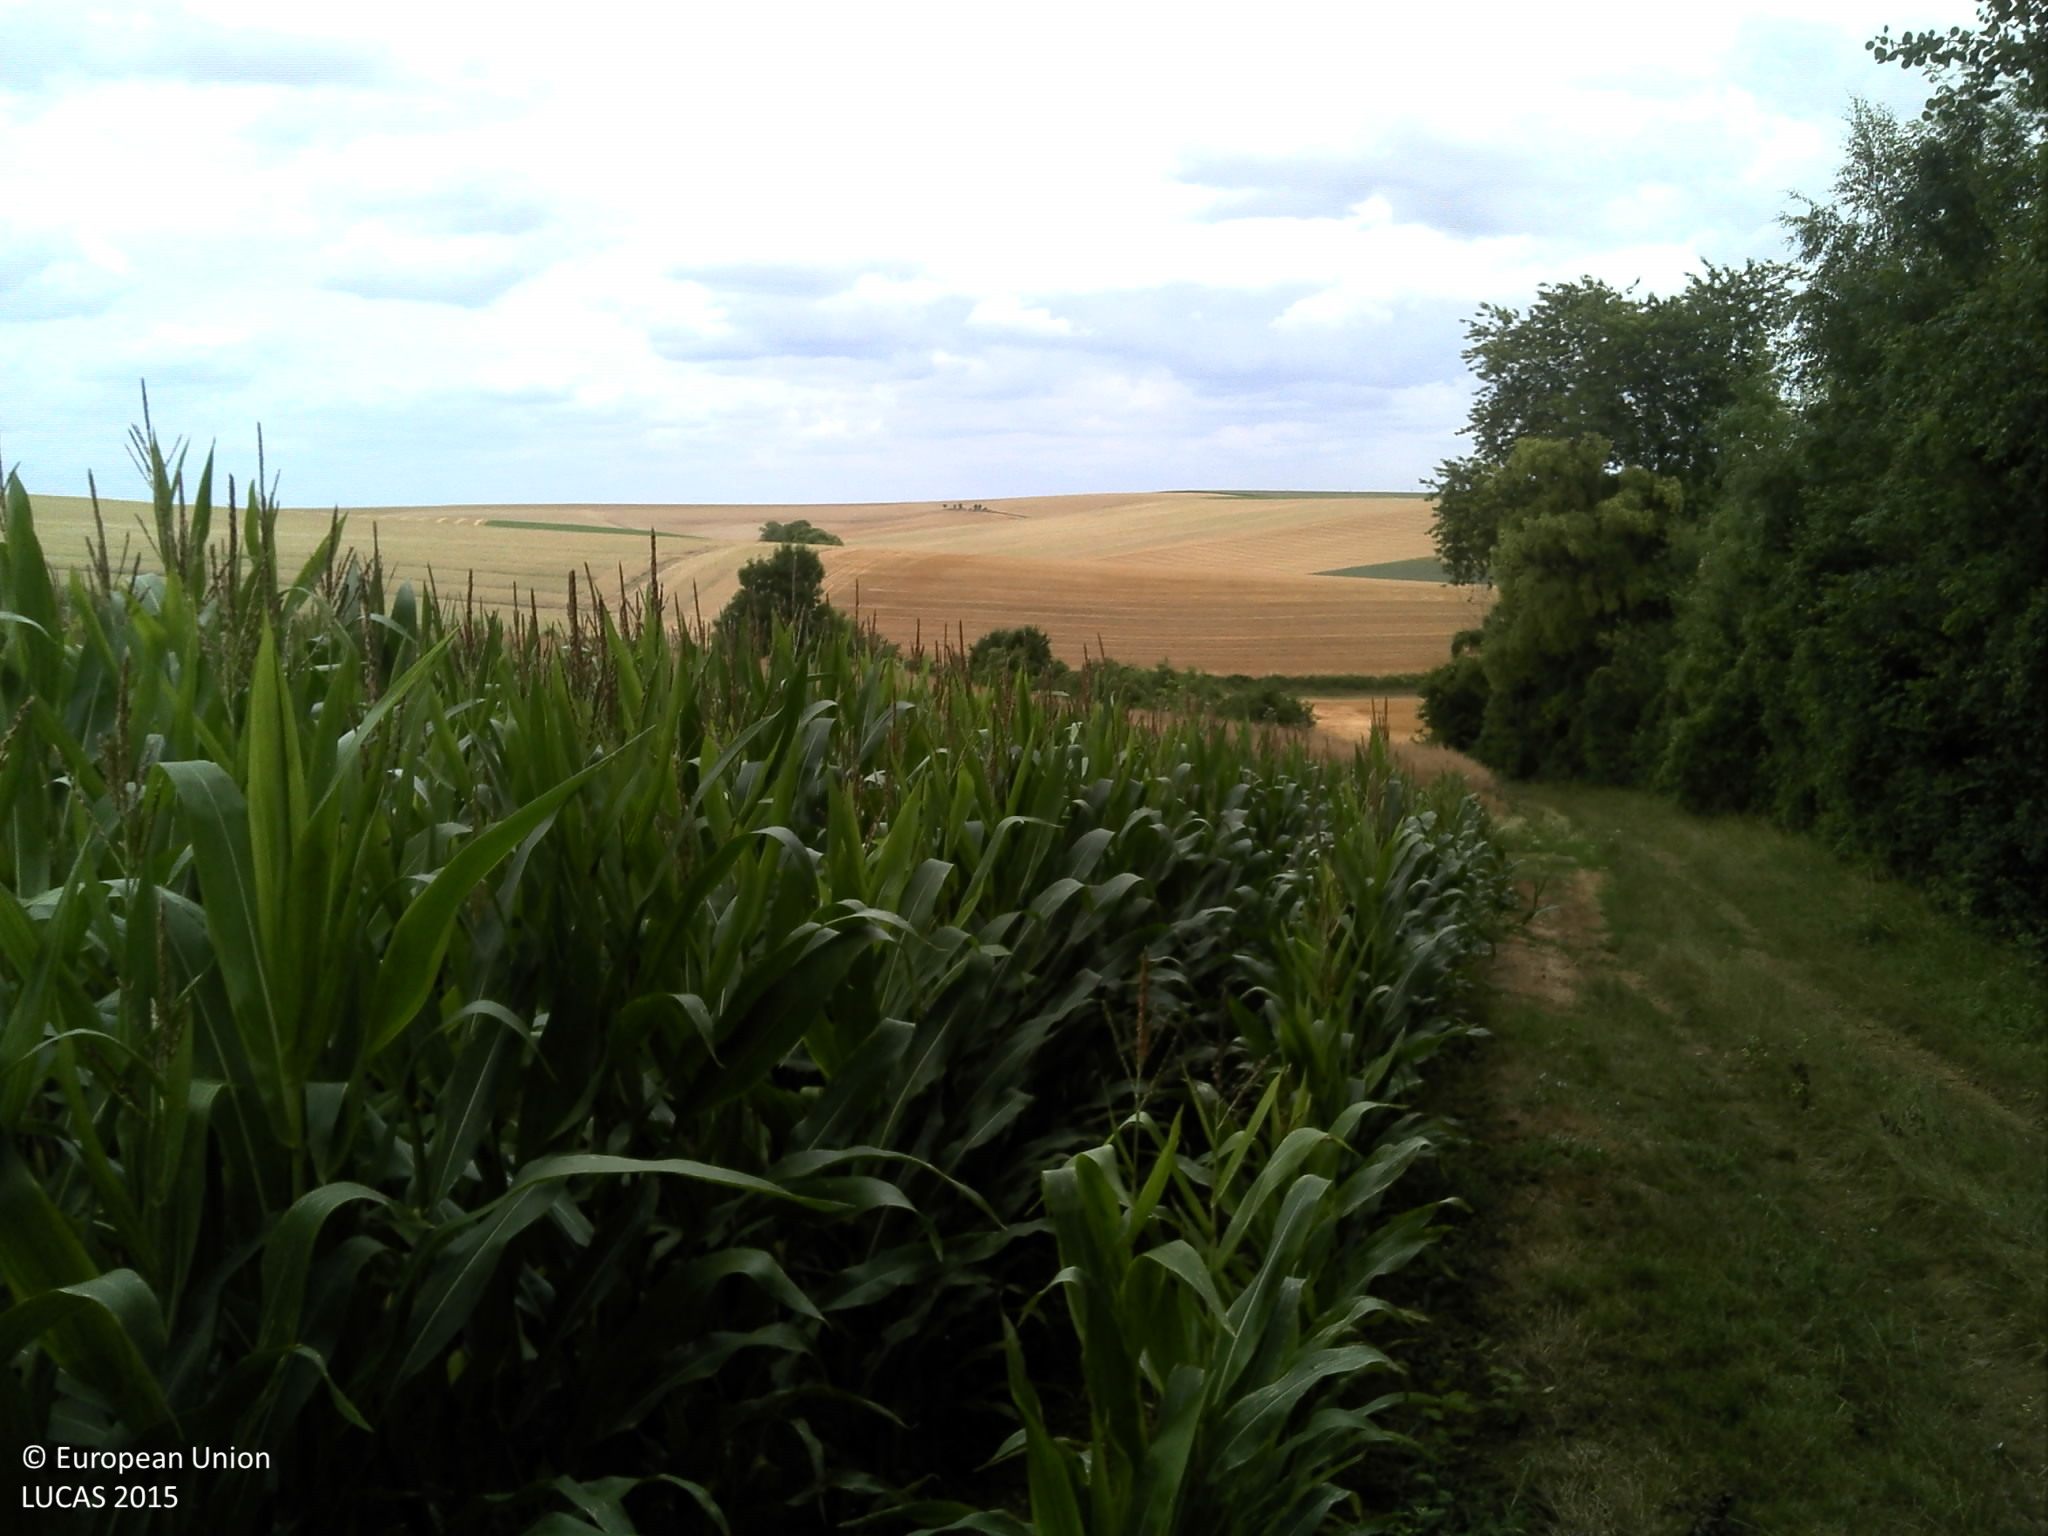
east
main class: Cropland
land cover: Maize
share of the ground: > 75 %
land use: Agriculture (excluding fallow land and kitchen gardens)
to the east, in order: Maize; Grass margins; Rape and turnip rape; Grassland without tree/shrub cover; Common wheat; Abandoned hedges; Common wheat
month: July
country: FR
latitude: 49.5830
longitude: 4.1444
